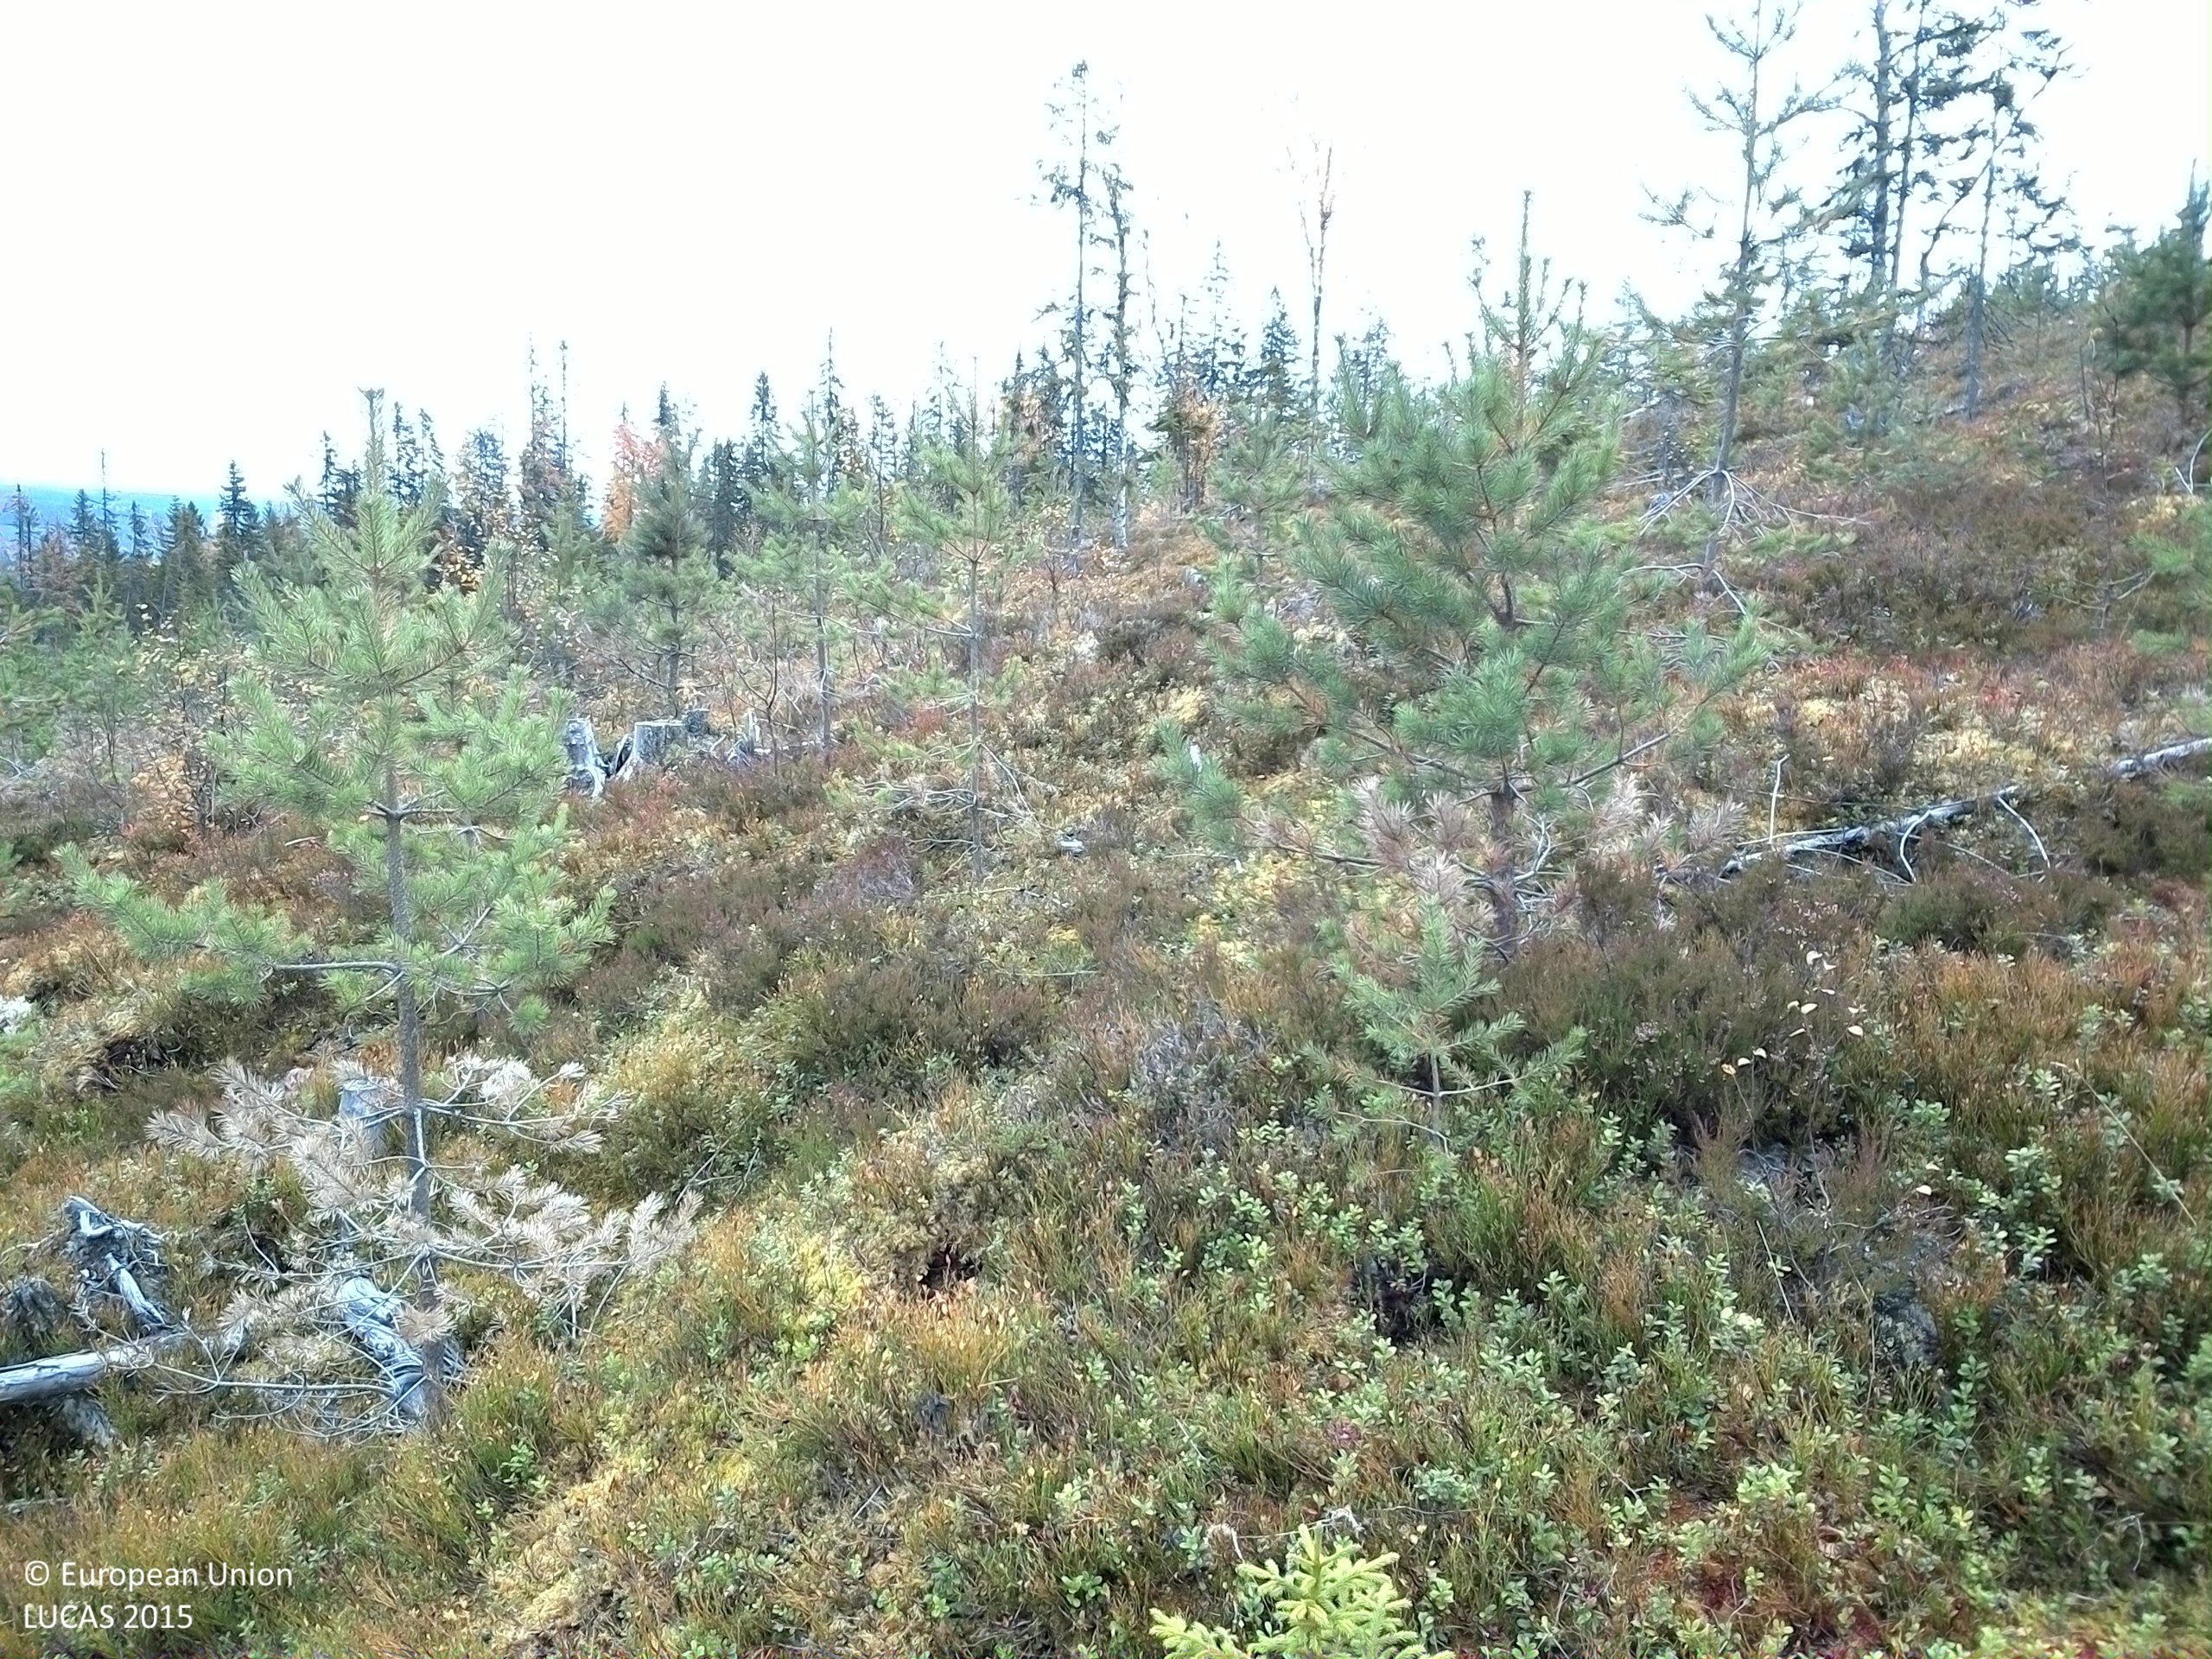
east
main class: Woodland
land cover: Pine dominated coniferous woodland
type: boreal forest
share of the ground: 25 - 50 %
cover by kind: coniferous forest trees 45 %, shrubs 25 %, lichens and mosses 15 %, consolidated bare surface 10 %, broadleaved forest trees 5 %
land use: Forestry
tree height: < 5 m
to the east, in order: Pine dominated coniferous woodland; Spruce dominated coniferous woodland; Spruce dominated mixed woodland; Spruce dominated coniferous woodland
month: October
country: SE
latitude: 61.3312
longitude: 14.6381
